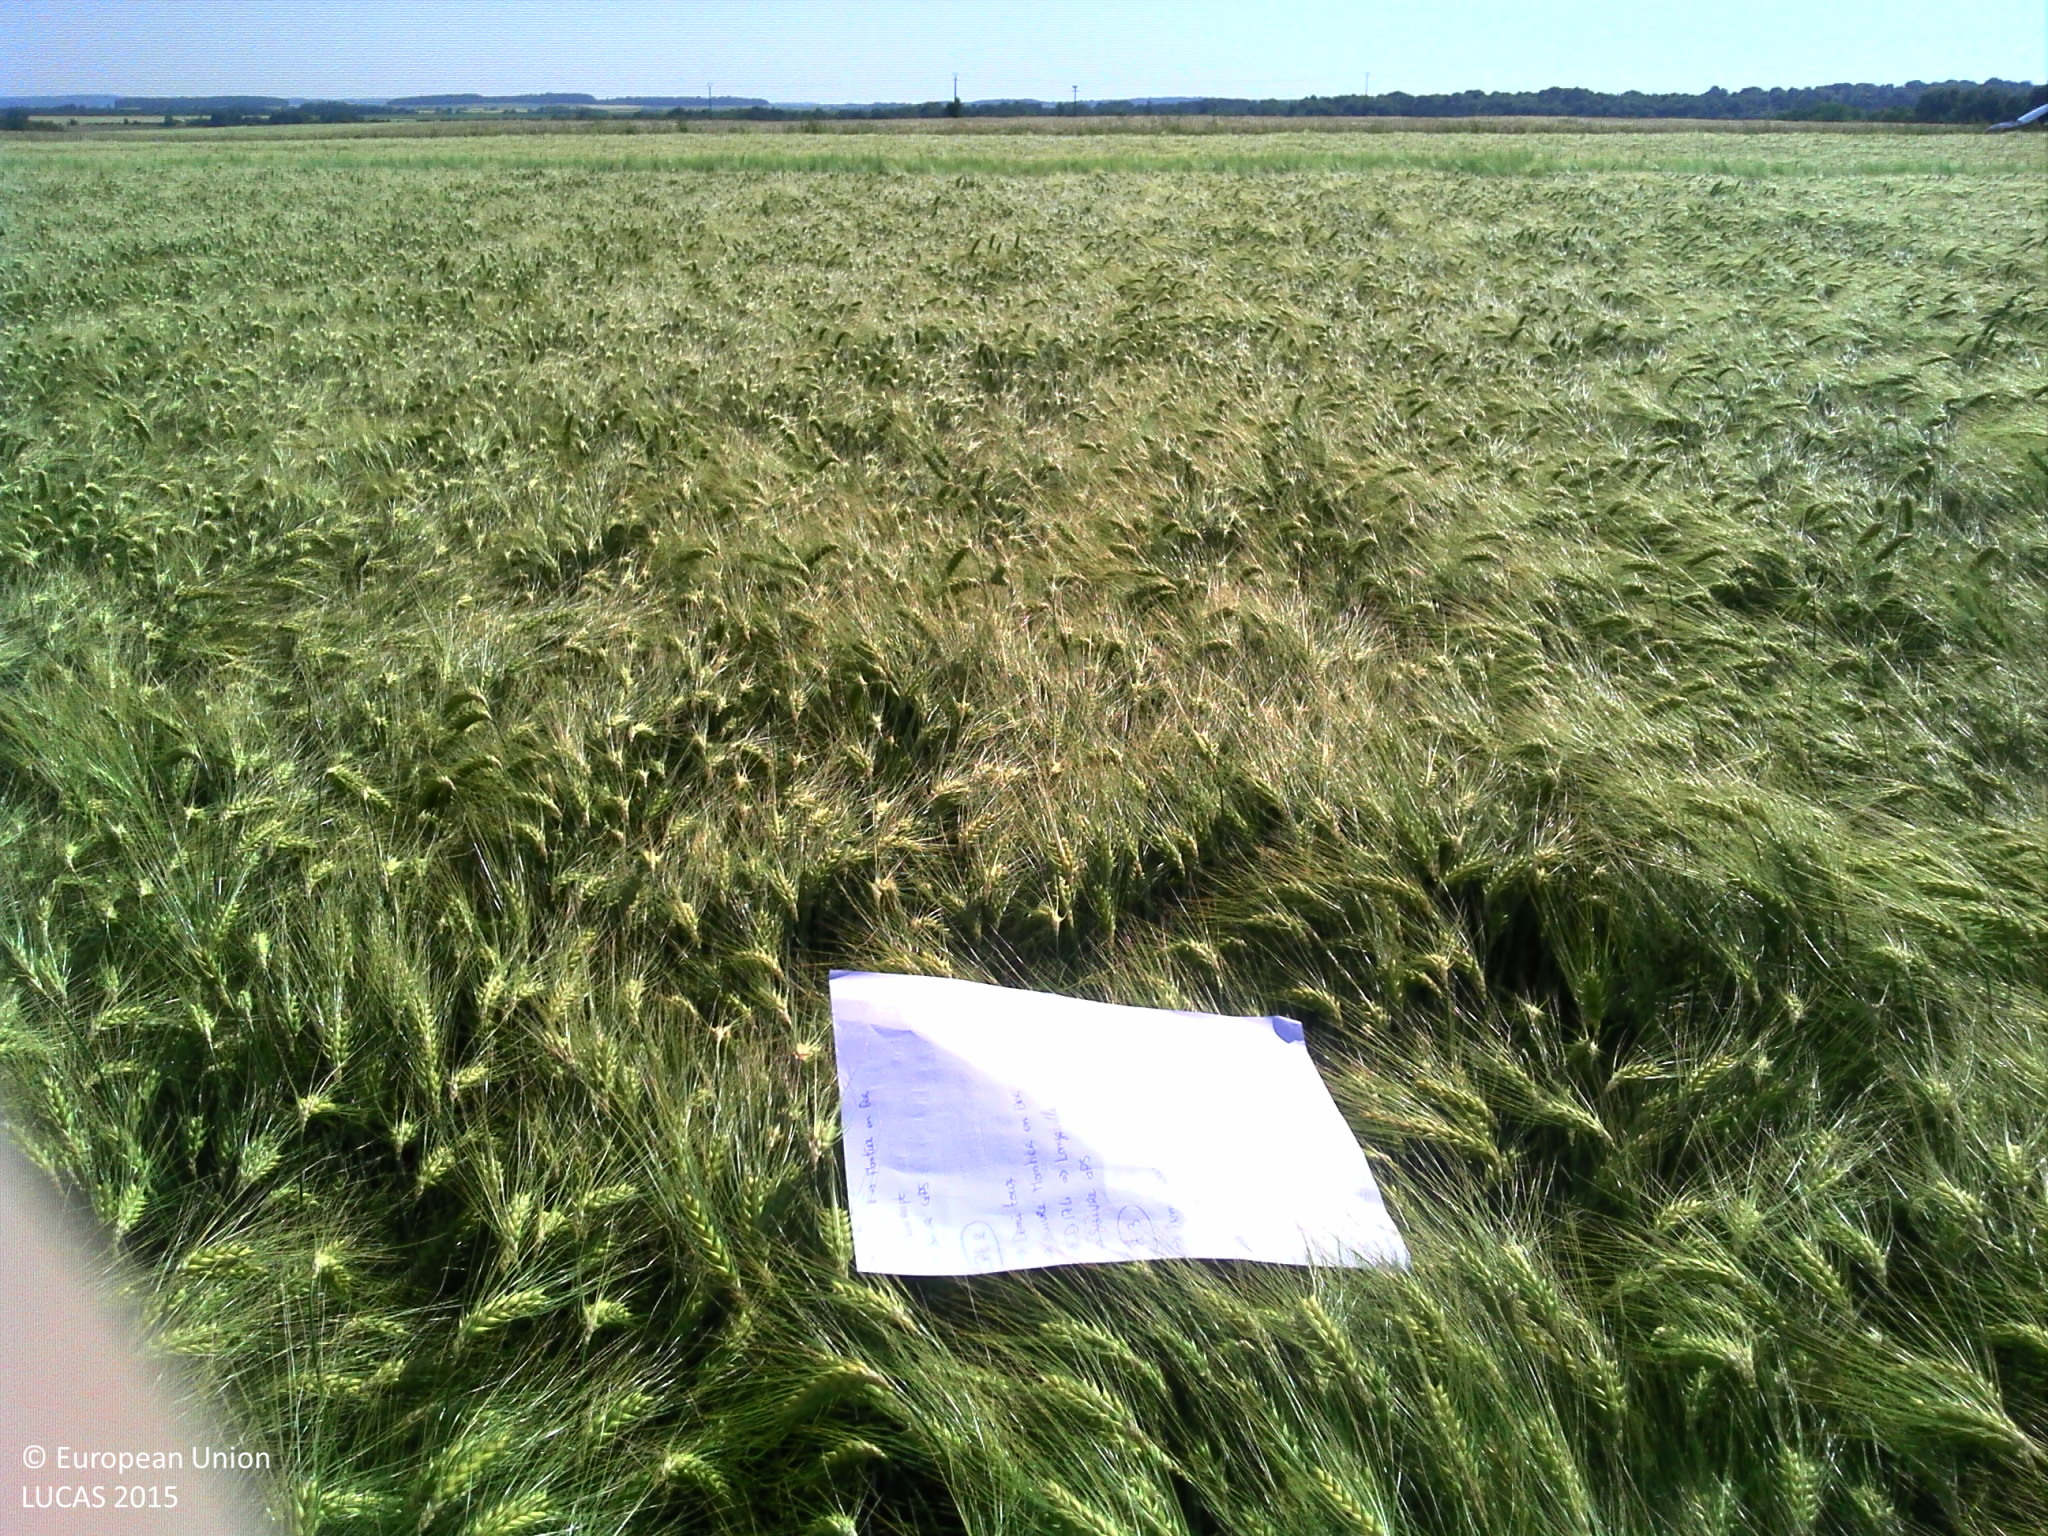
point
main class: Cropland
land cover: Barley
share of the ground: > 75 %
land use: Agriculture (excluding fallow land and kitchen gardens)
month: June
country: FR
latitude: 48.3764
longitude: 4.9085
